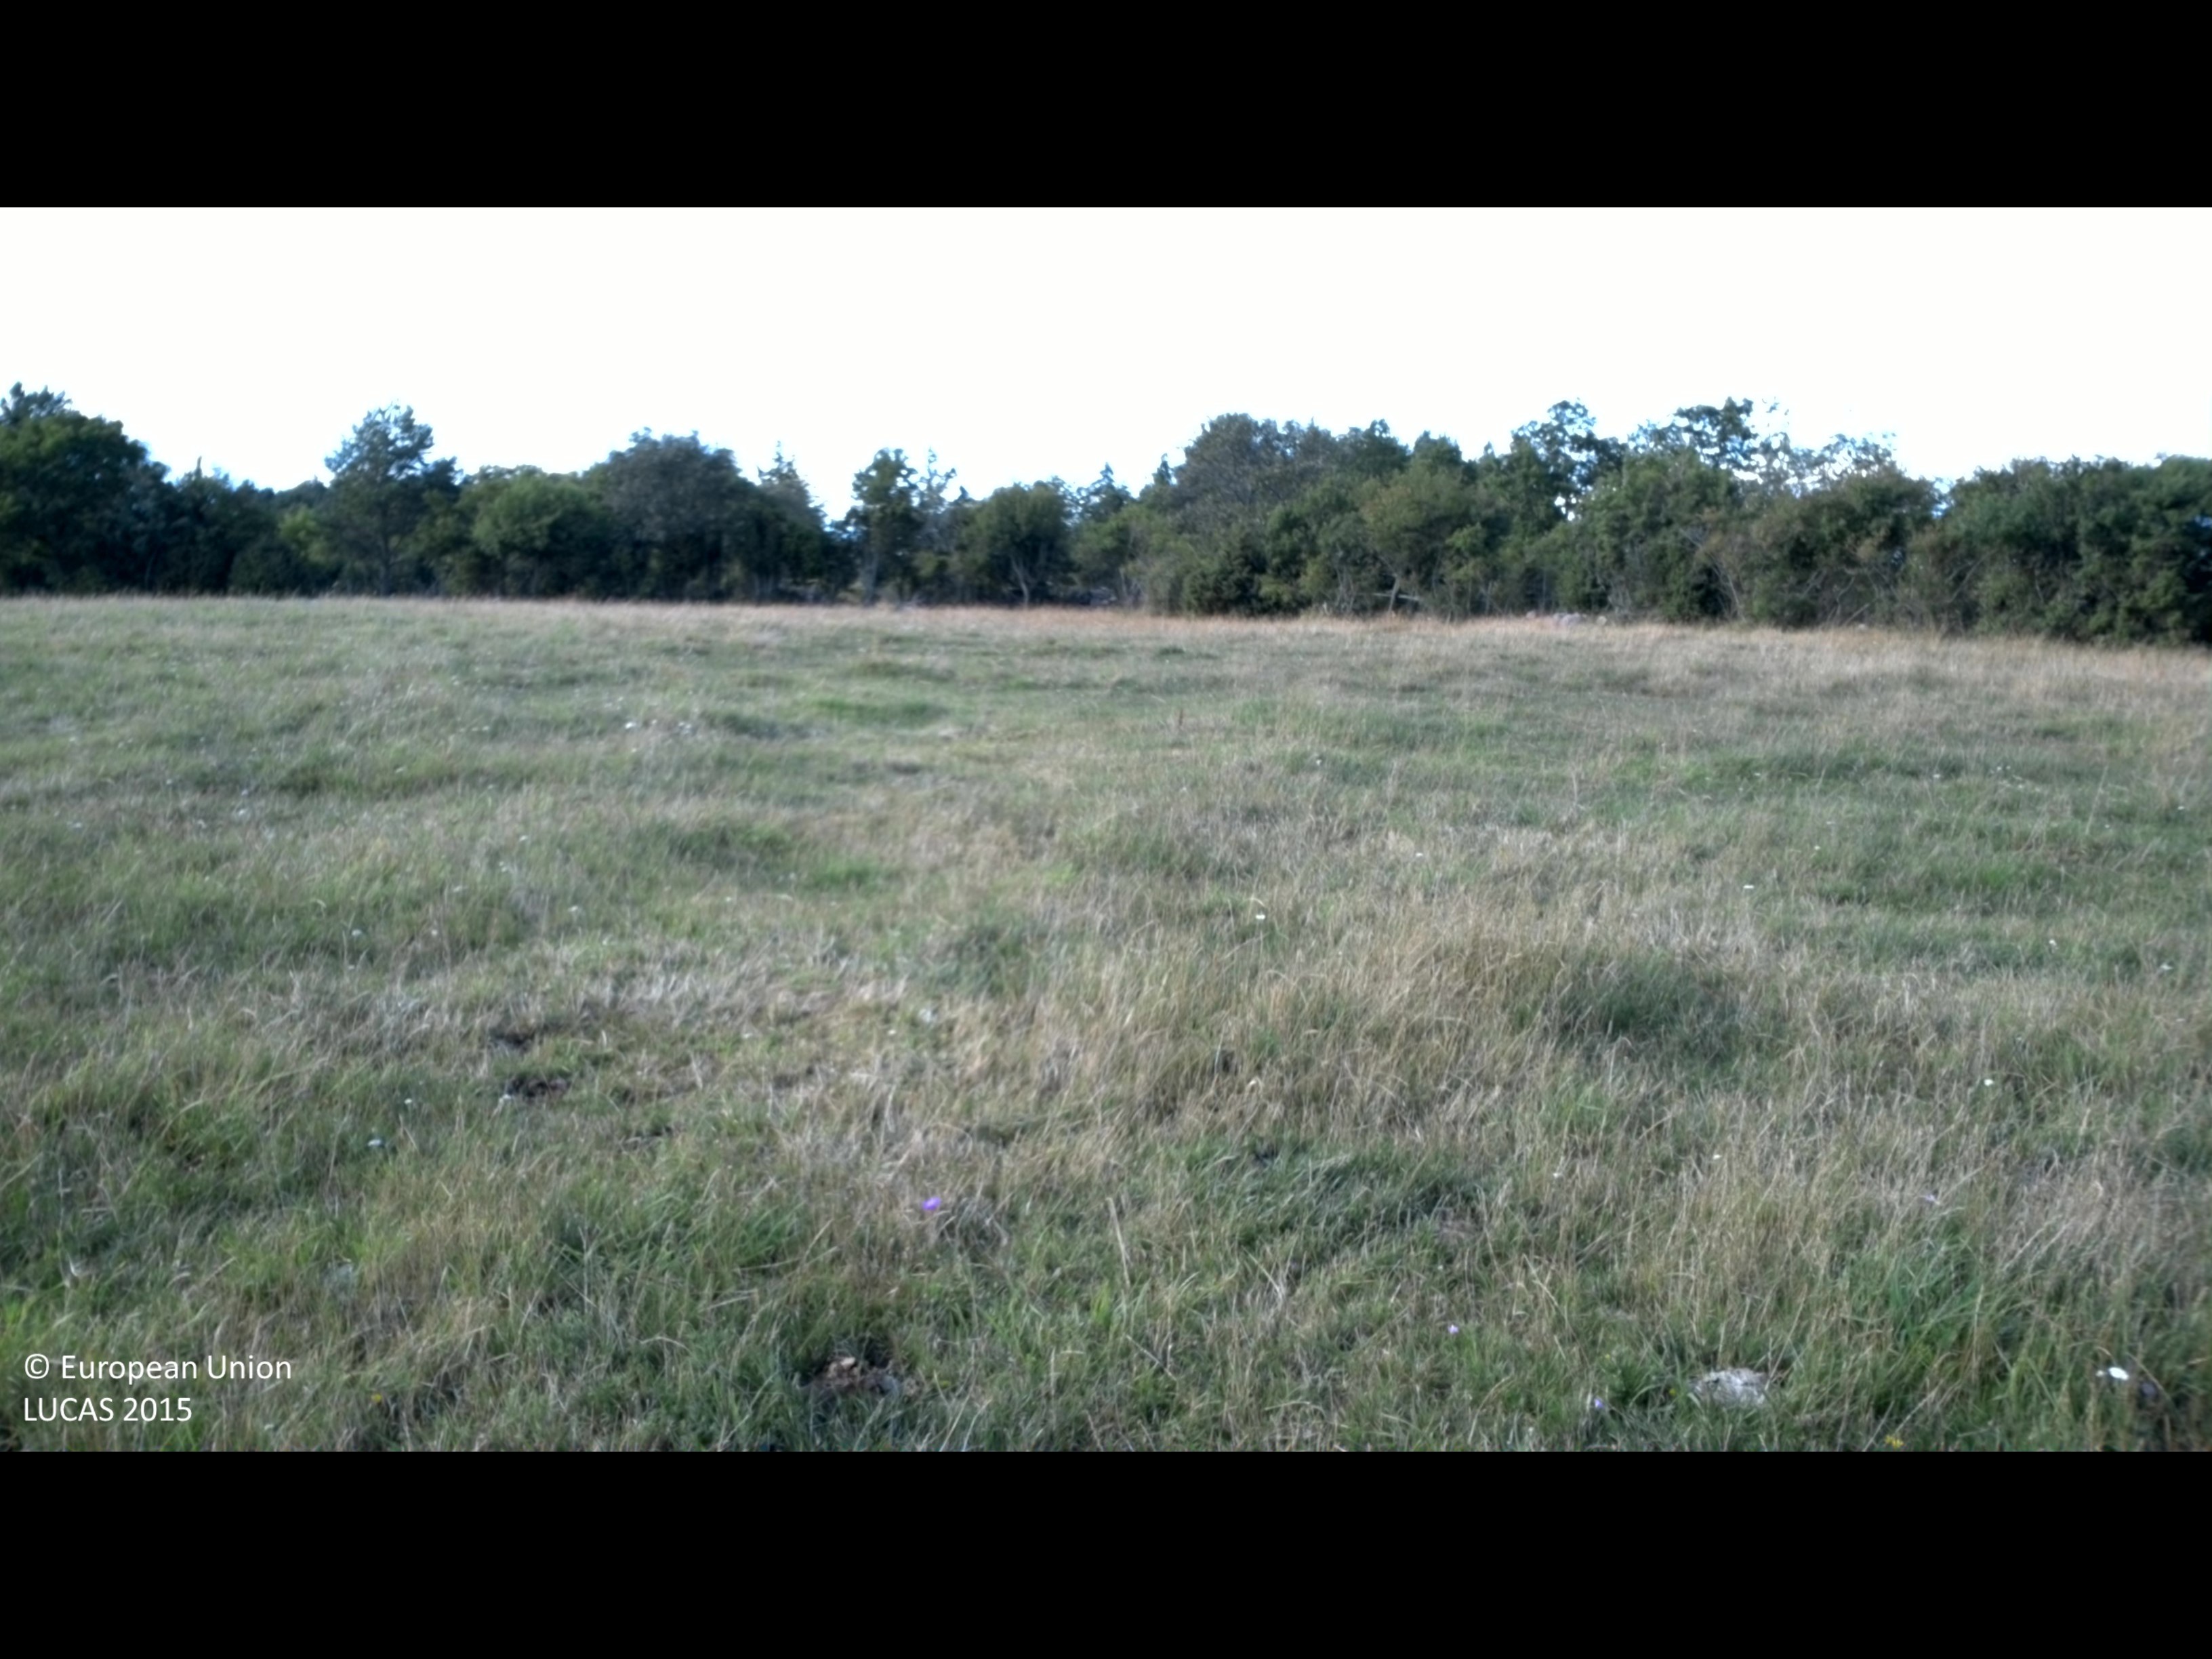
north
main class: Grassland
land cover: Grassland without tree/shrub cover
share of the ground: > 75 %
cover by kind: herbaceous plants 100 %
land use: Agriculture (excluding fallow land and kitchen gardens)
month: July
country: SE
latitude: 57.1899
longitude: 16.9680
